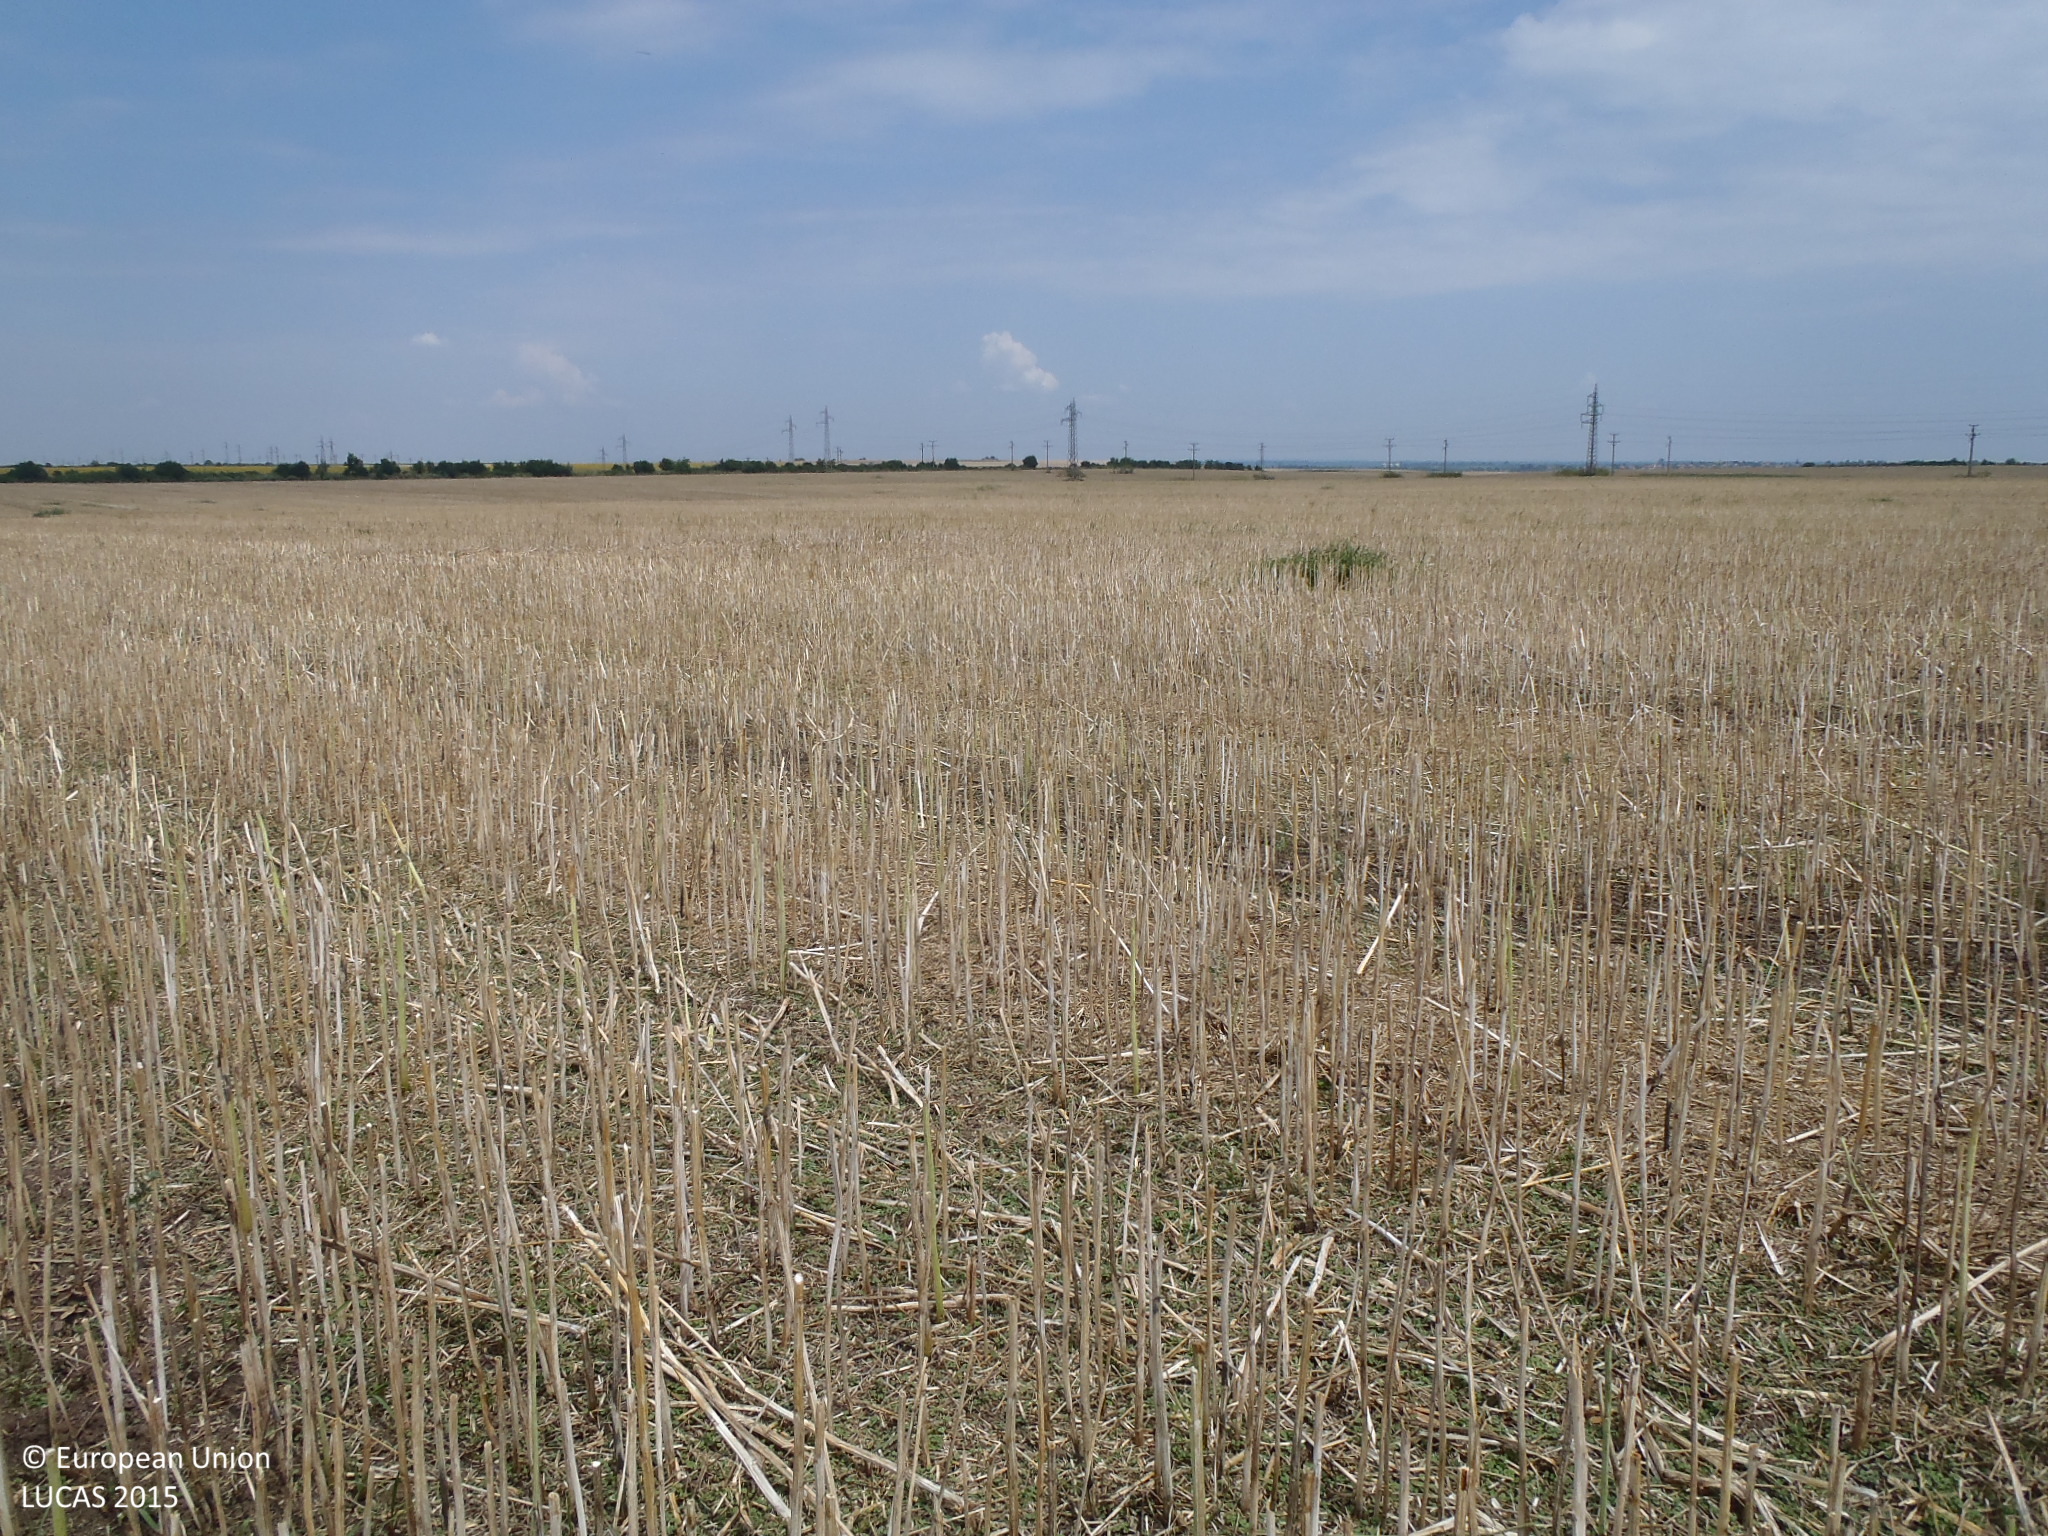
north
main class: Cropland
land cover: Rape and turnip rape
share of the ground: < 10 %
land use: Agriculture (excluding fallow land and kitchen gardens)
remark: Harvested field
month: July
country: BG
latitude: 43.9313
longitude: 26.3108
